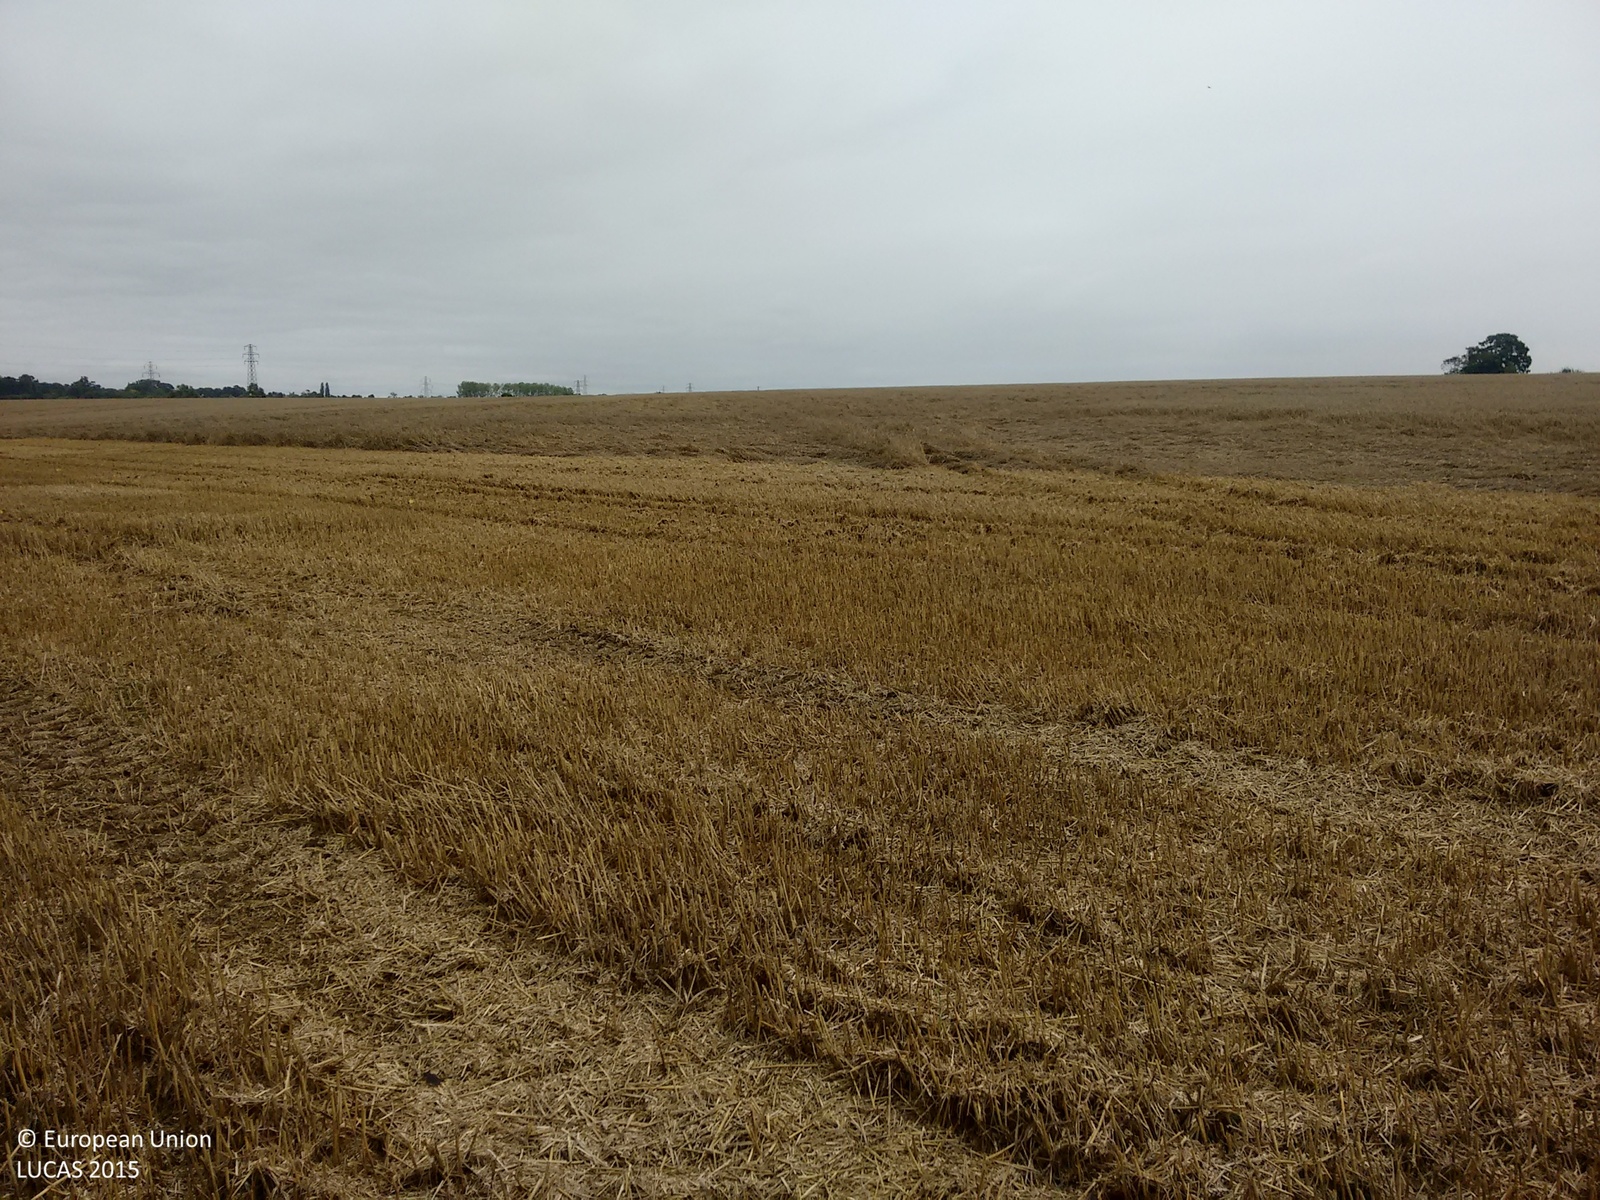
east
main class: Cropland
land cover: Common wheat
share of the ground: > 75 %
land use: Agriculture (excluding fallow land and kitchen gardens)
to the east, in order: Common wheat
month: September
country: GB
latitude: 52.1740
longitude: 0.9247
